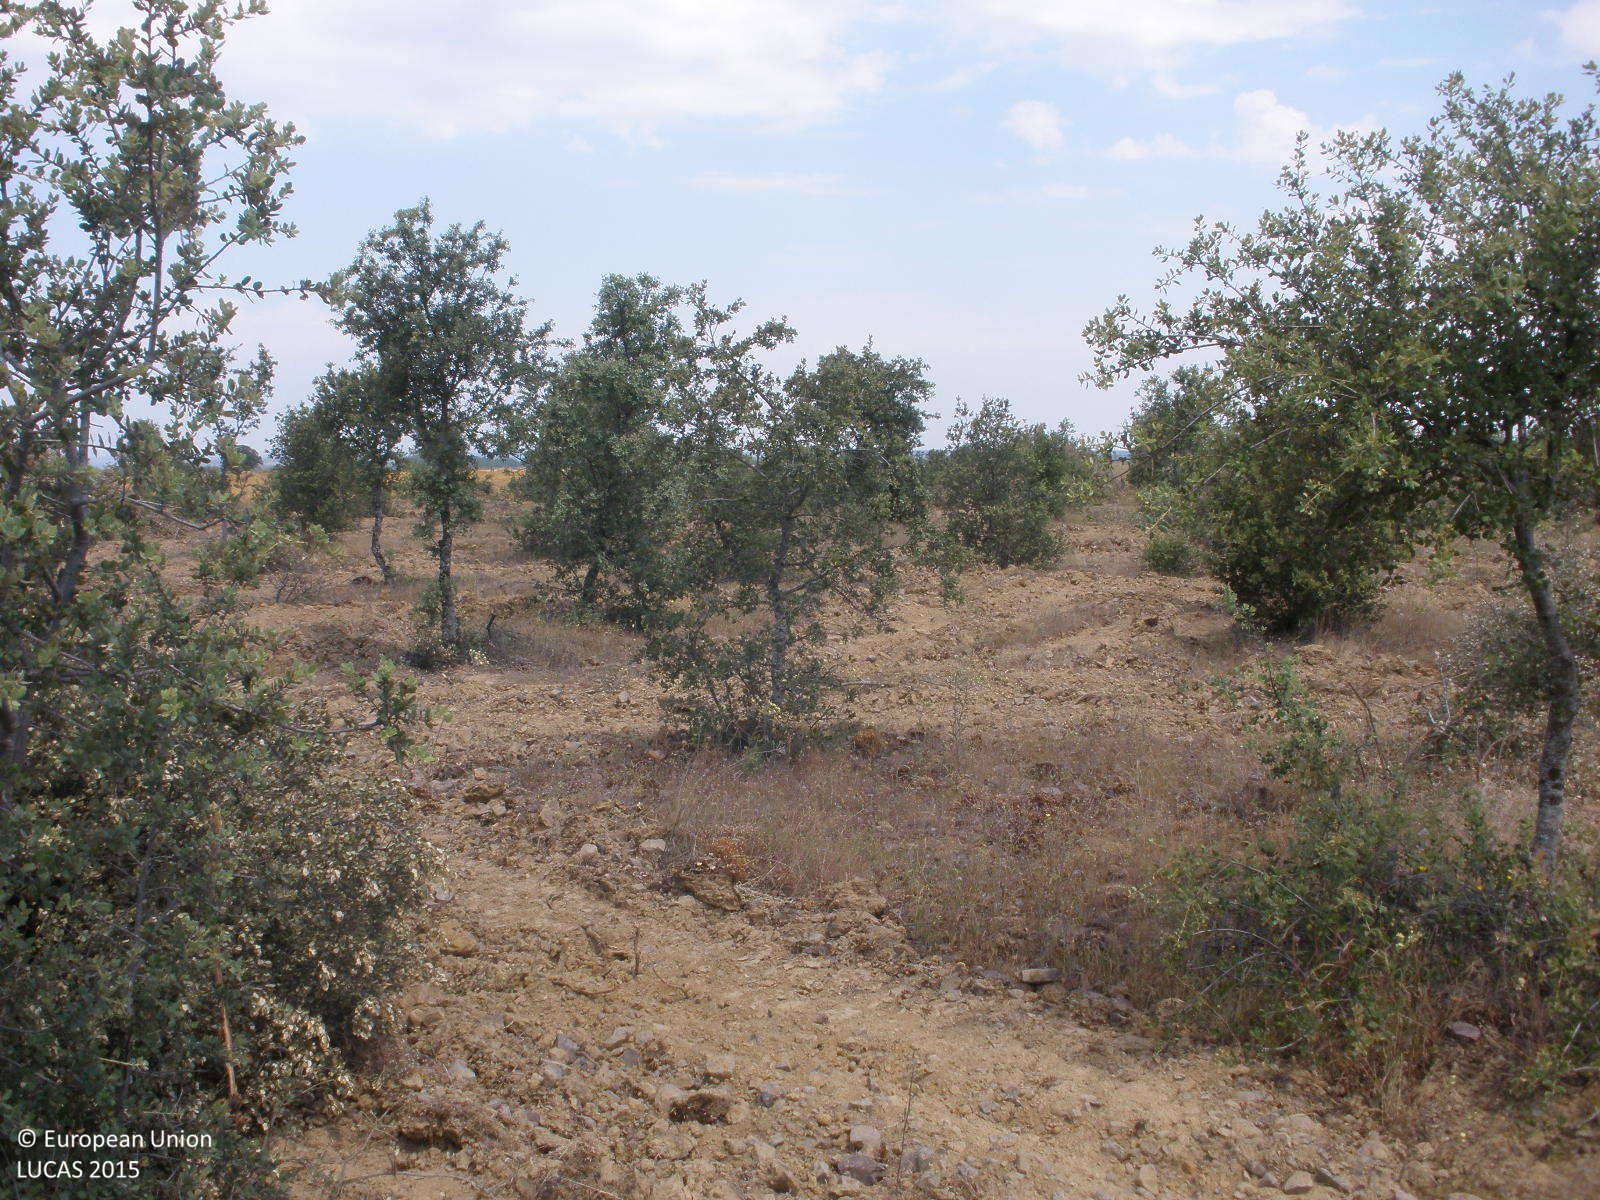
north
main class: Woodland
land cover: Broadleaved woodland
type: broadleaved evergreen forest
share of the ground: 50 - 75 %
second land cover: Spontaneously vegetated surfaces
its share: 25 - 50 %
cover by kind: broadleaved forest trees 50 %, unconsolidated bare surface 40 %, herbaceous plants 10 %
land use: Forestry
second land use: Fallow land
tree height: < 5 m
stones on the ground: > 50 %
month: June
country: ES
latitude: 40.6078
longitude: -6.2881
